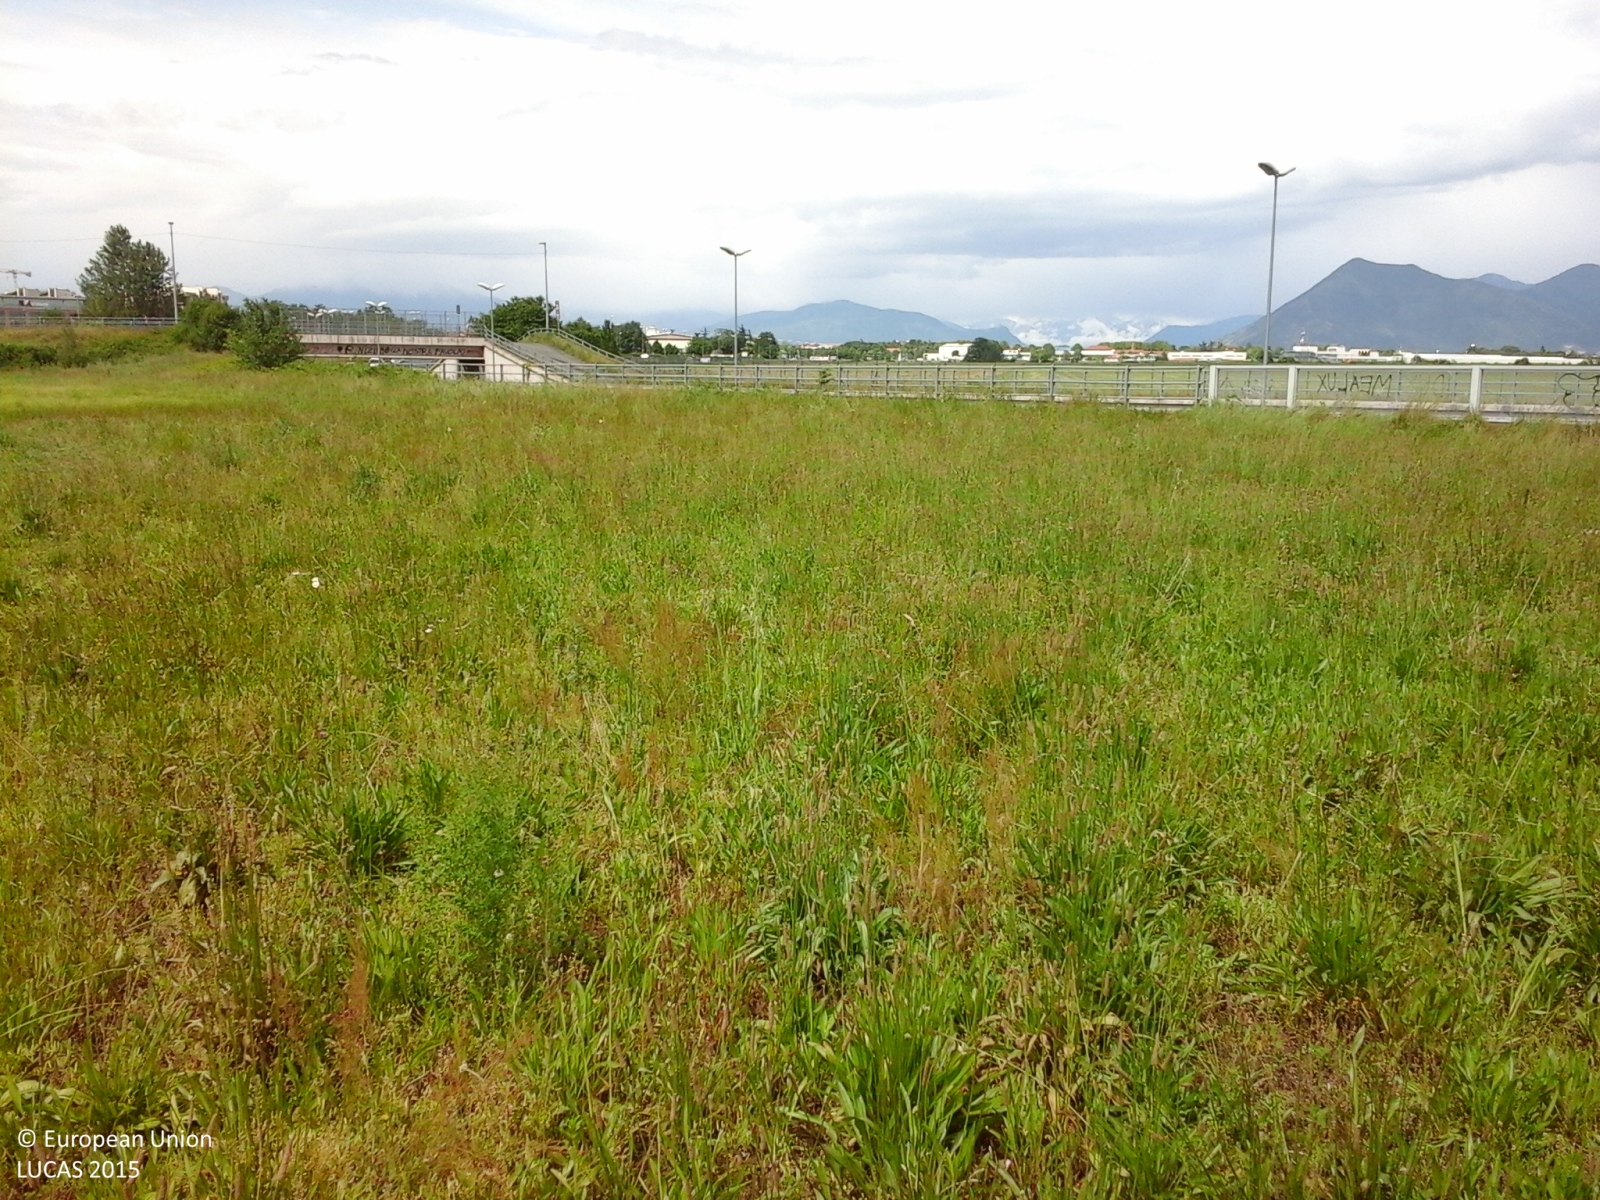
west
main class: Cropland
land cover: Temporary grasslands
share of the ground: > 75 %
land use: Agriculture (excluding fallow land and kitchen gardens)
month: May
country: IT
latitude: 45.0805
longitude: 7.6032
